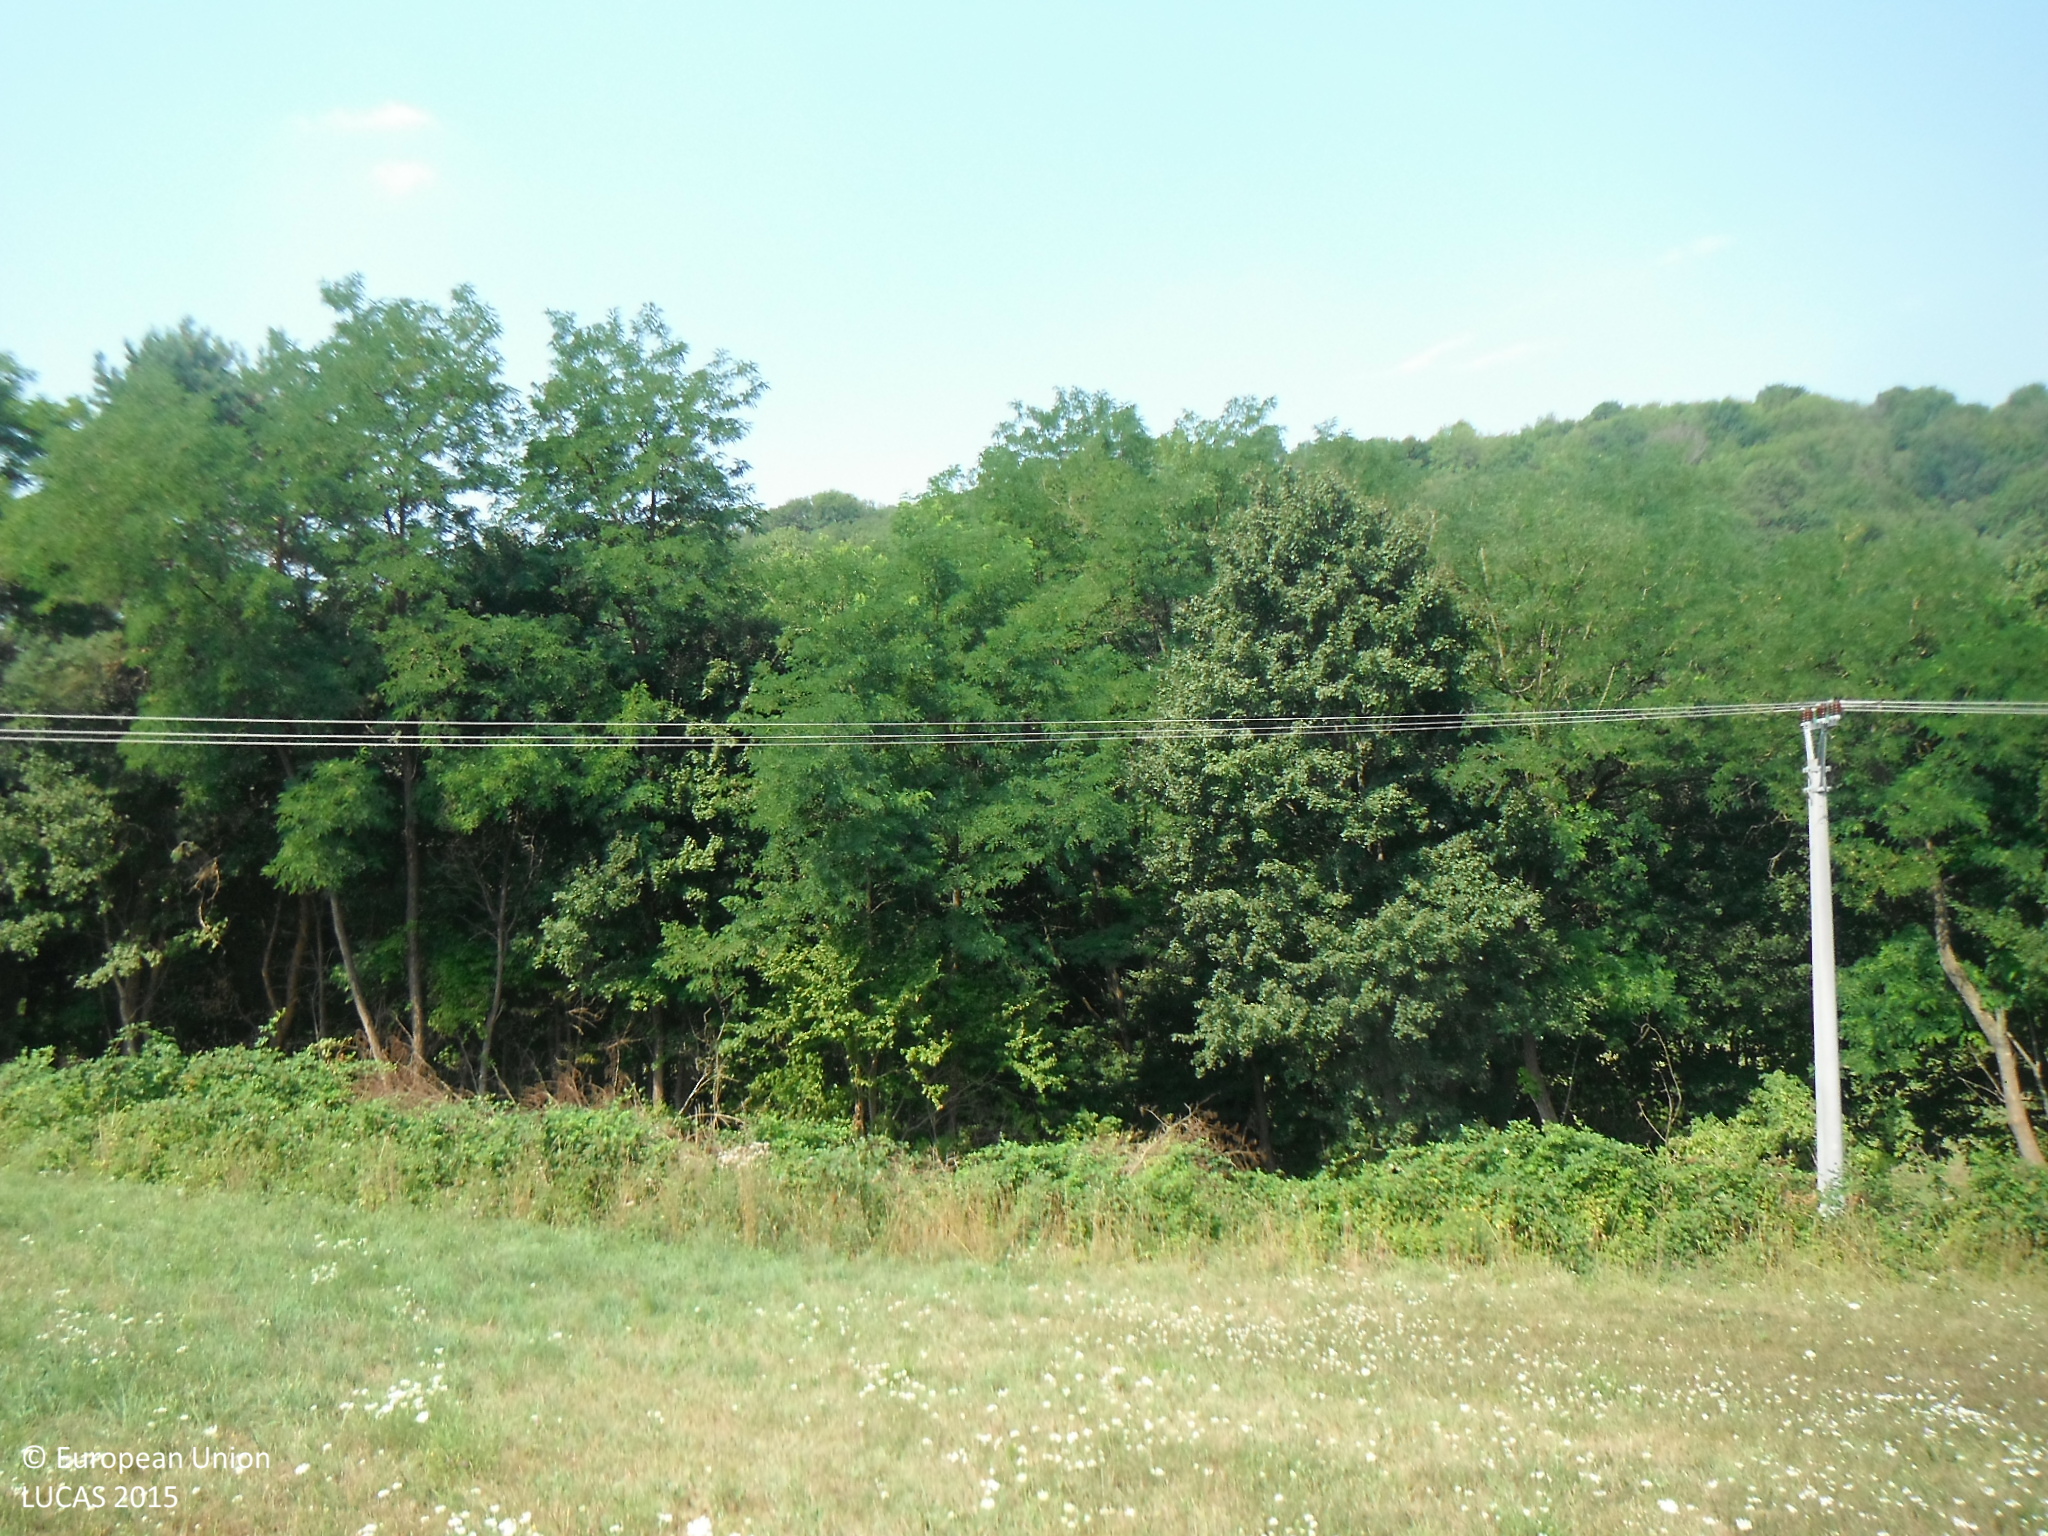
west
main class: Grassland
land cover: Grassland without tree/shrub cover
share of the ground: > 75 %
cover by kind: herbaceous plants 100 %
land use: Agriculture (excluding fallow land and kitchen gardens)
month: July
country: SK
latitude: 48.6748
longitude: 17.4665
